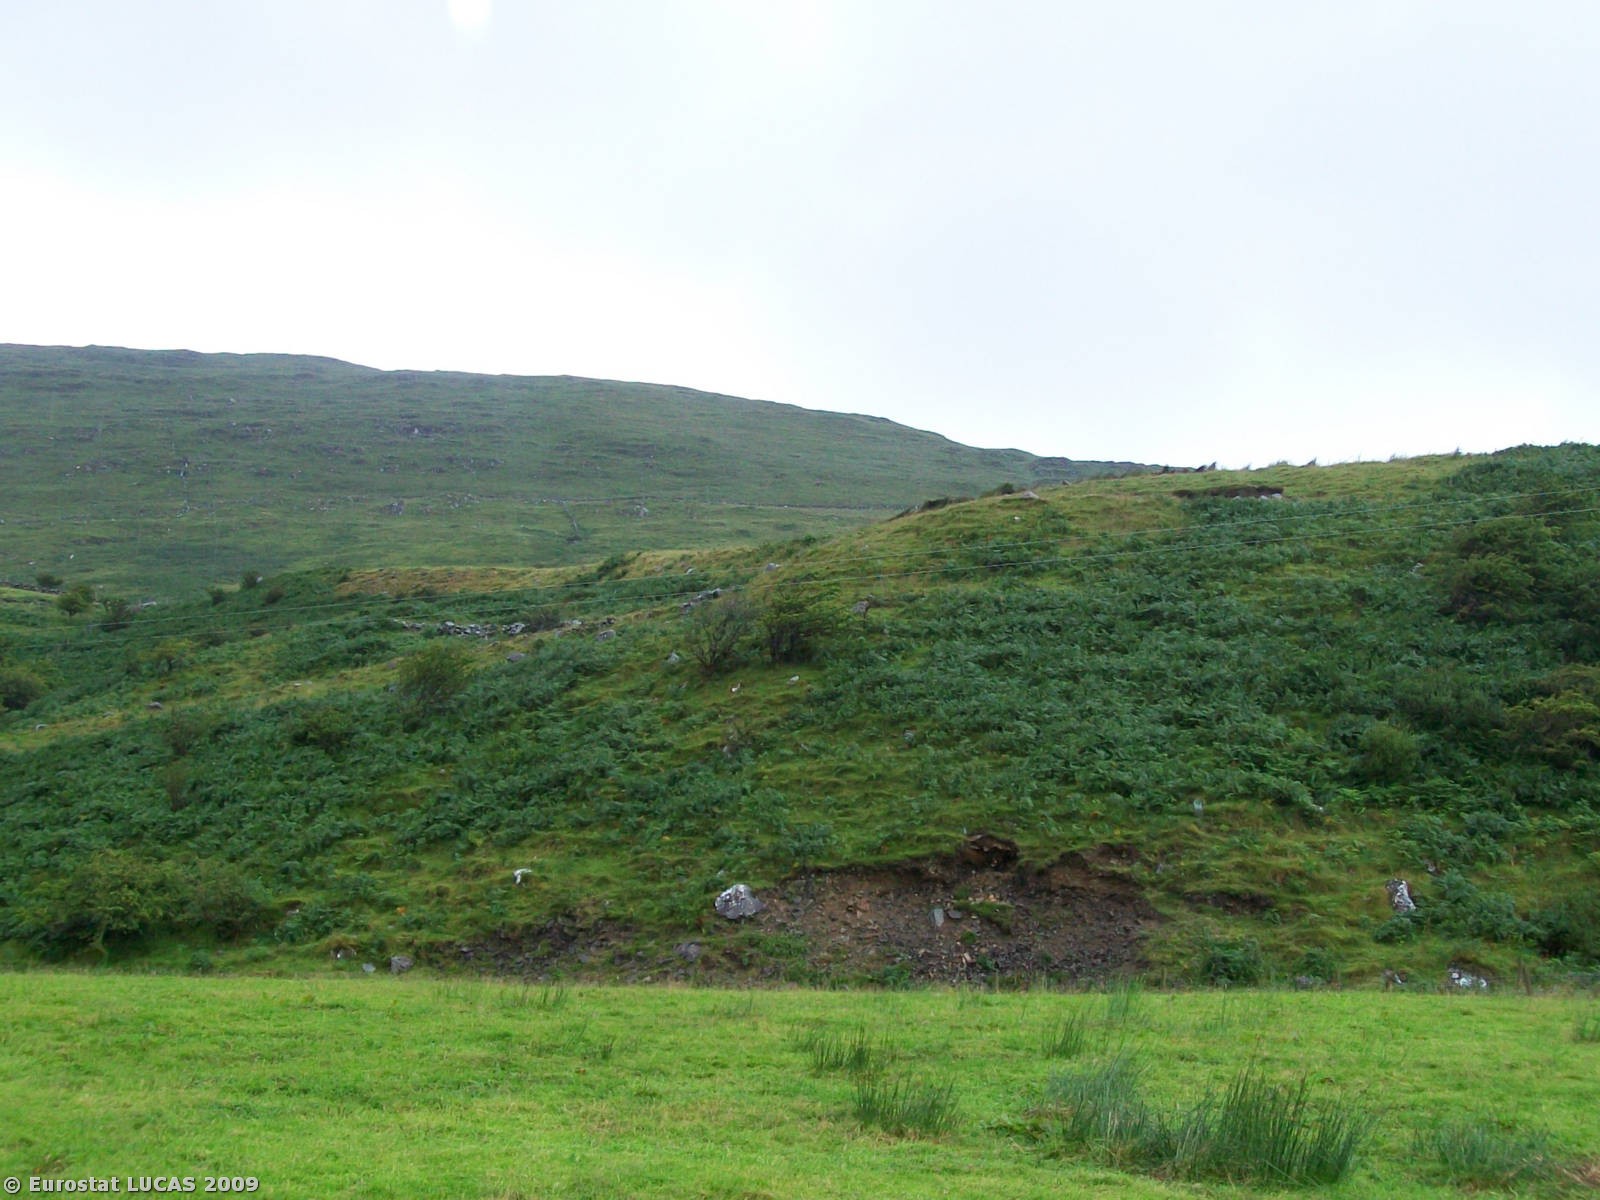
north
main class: Grassland
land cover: Grassland without tree/shrub cover
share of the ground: > 75 %
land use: Agriculture (excluding fallow land and kitchen gardens)
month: July
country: IE
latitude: 53.5309
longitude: -9.5293
